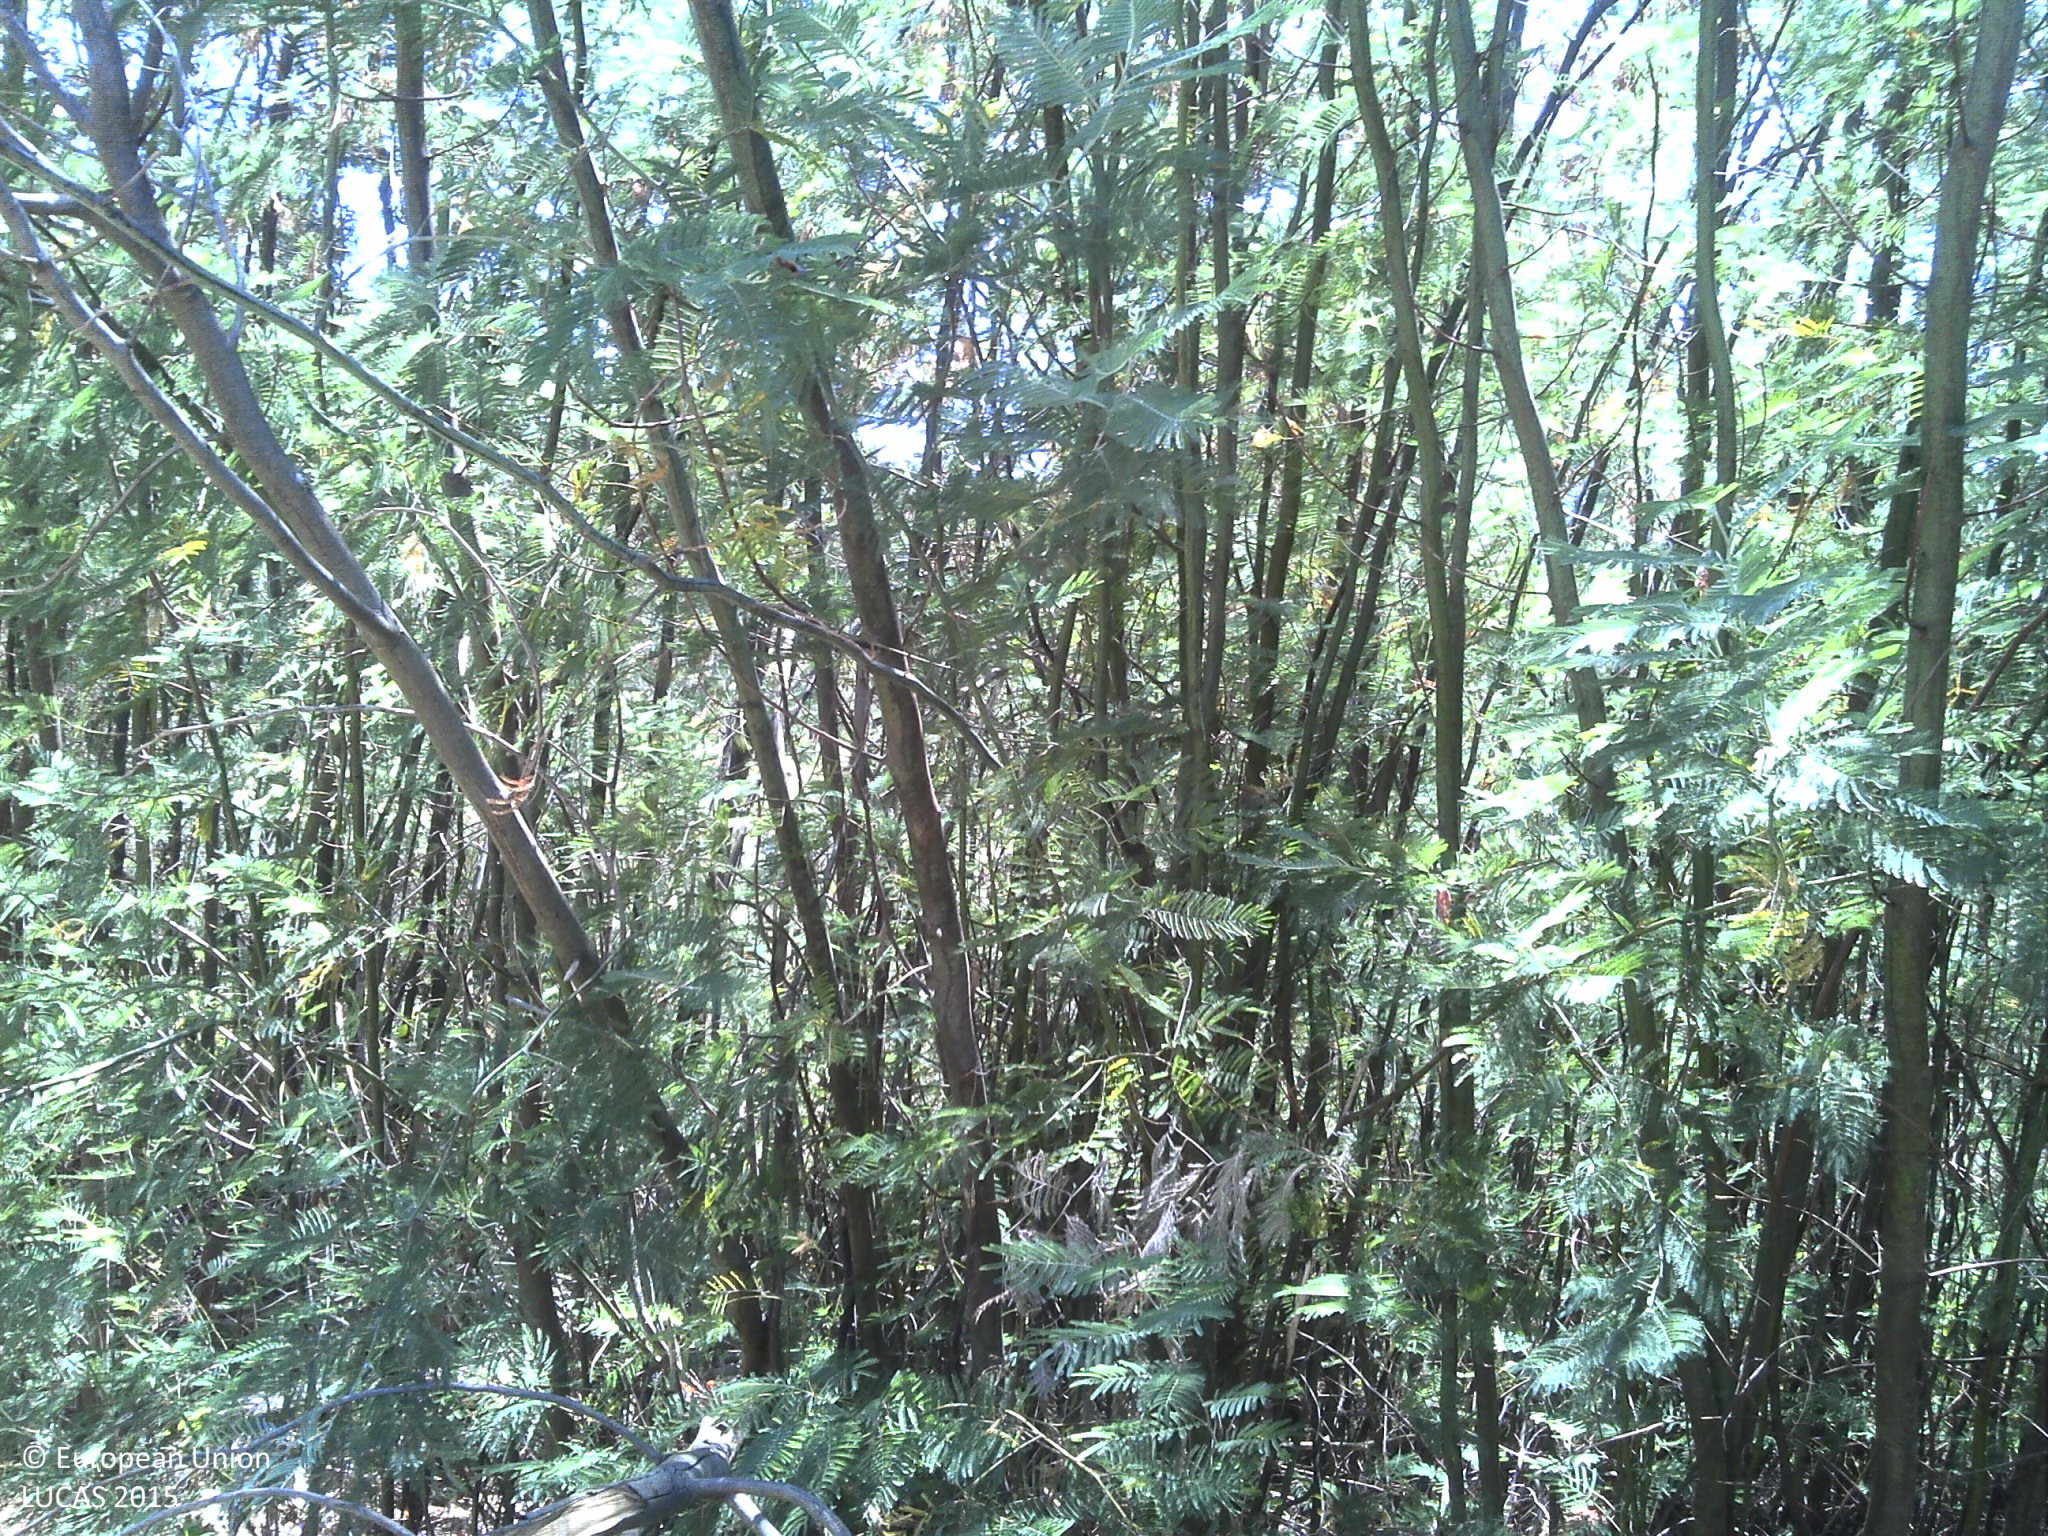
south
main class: Woodland
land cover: Broadleaved woodland
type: exotic forest
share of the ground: > 75 %
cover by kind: broadleaved forest trees 80 %, shrubs 20 %
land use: Abandoned areas
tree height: > 5 m
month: July
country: PT
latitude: 40.2451
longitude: -7.9270
